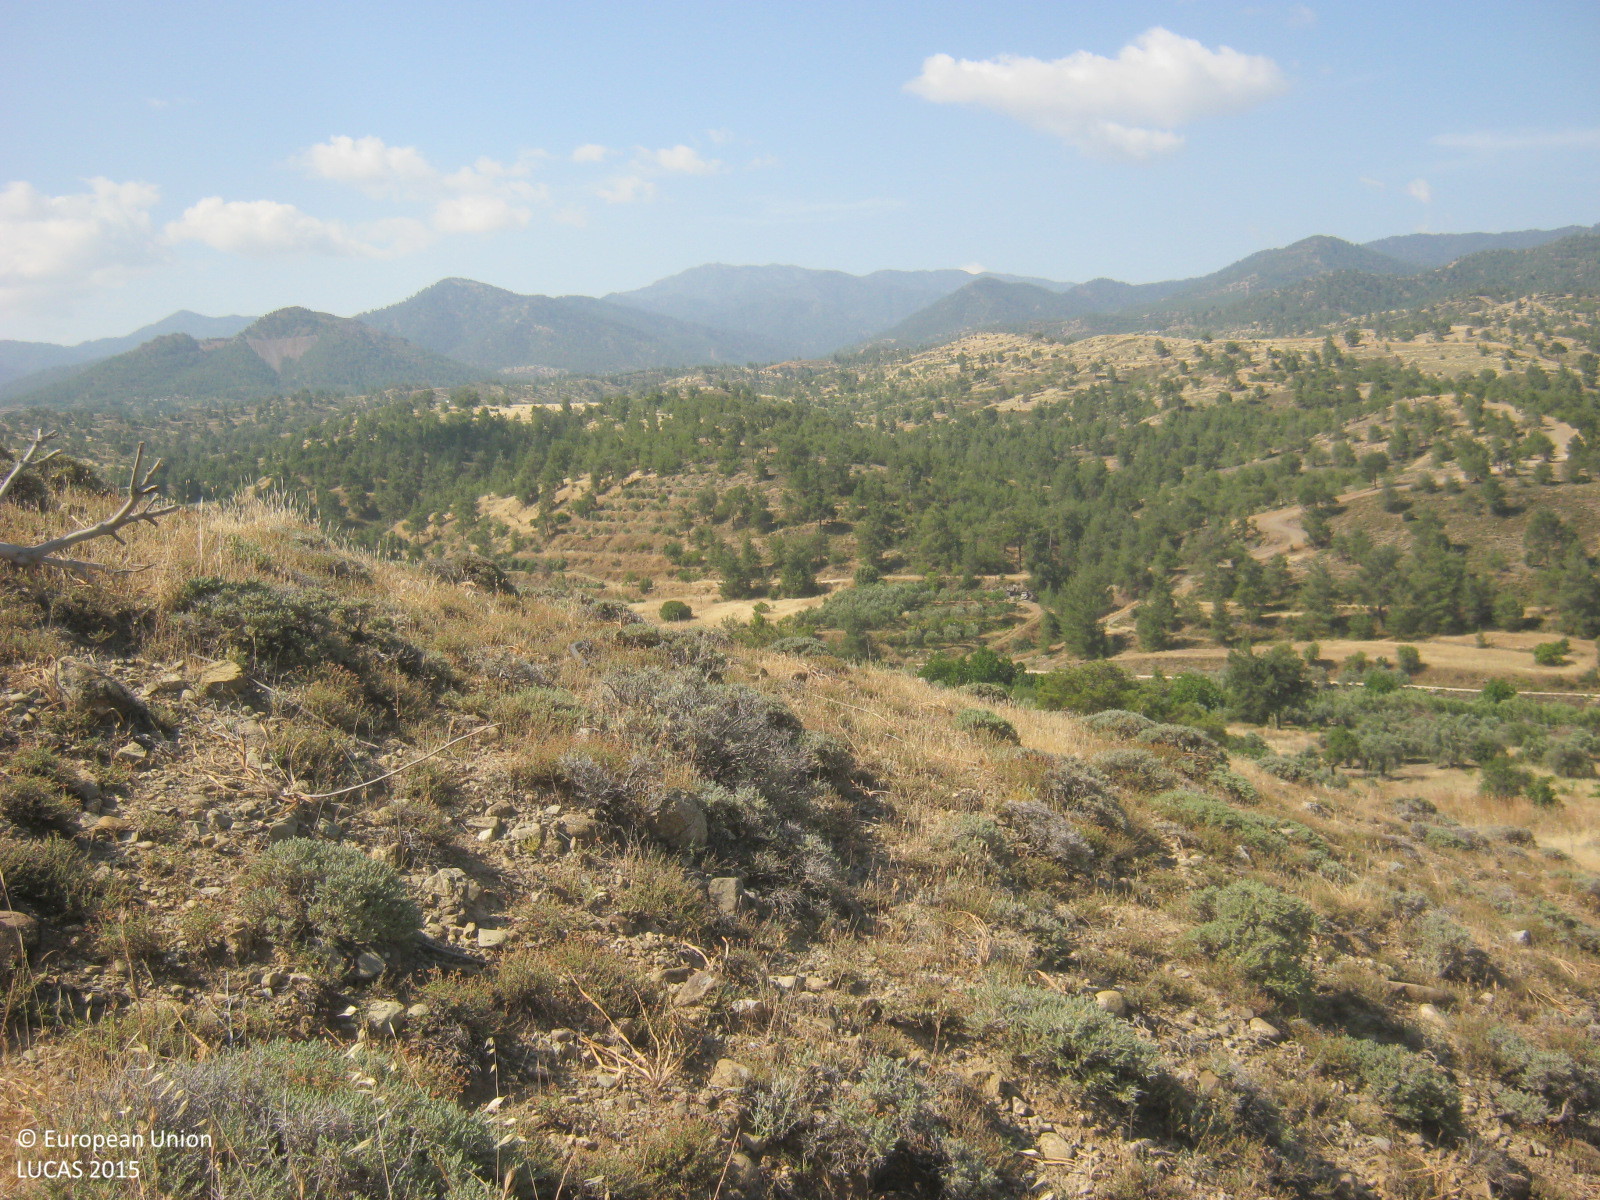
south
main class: Shrubland
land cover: Shrubland without tree cover
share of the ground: 25 - 50 %
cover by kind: herbaceous plants 55 %, shrubs 35 %, unconsolidated bare surface 10 %
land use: Semi-natural and natural areas not in use
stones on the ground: 25 - 50 %
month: May
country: CY
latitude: 35.0703
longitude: 33.0194
